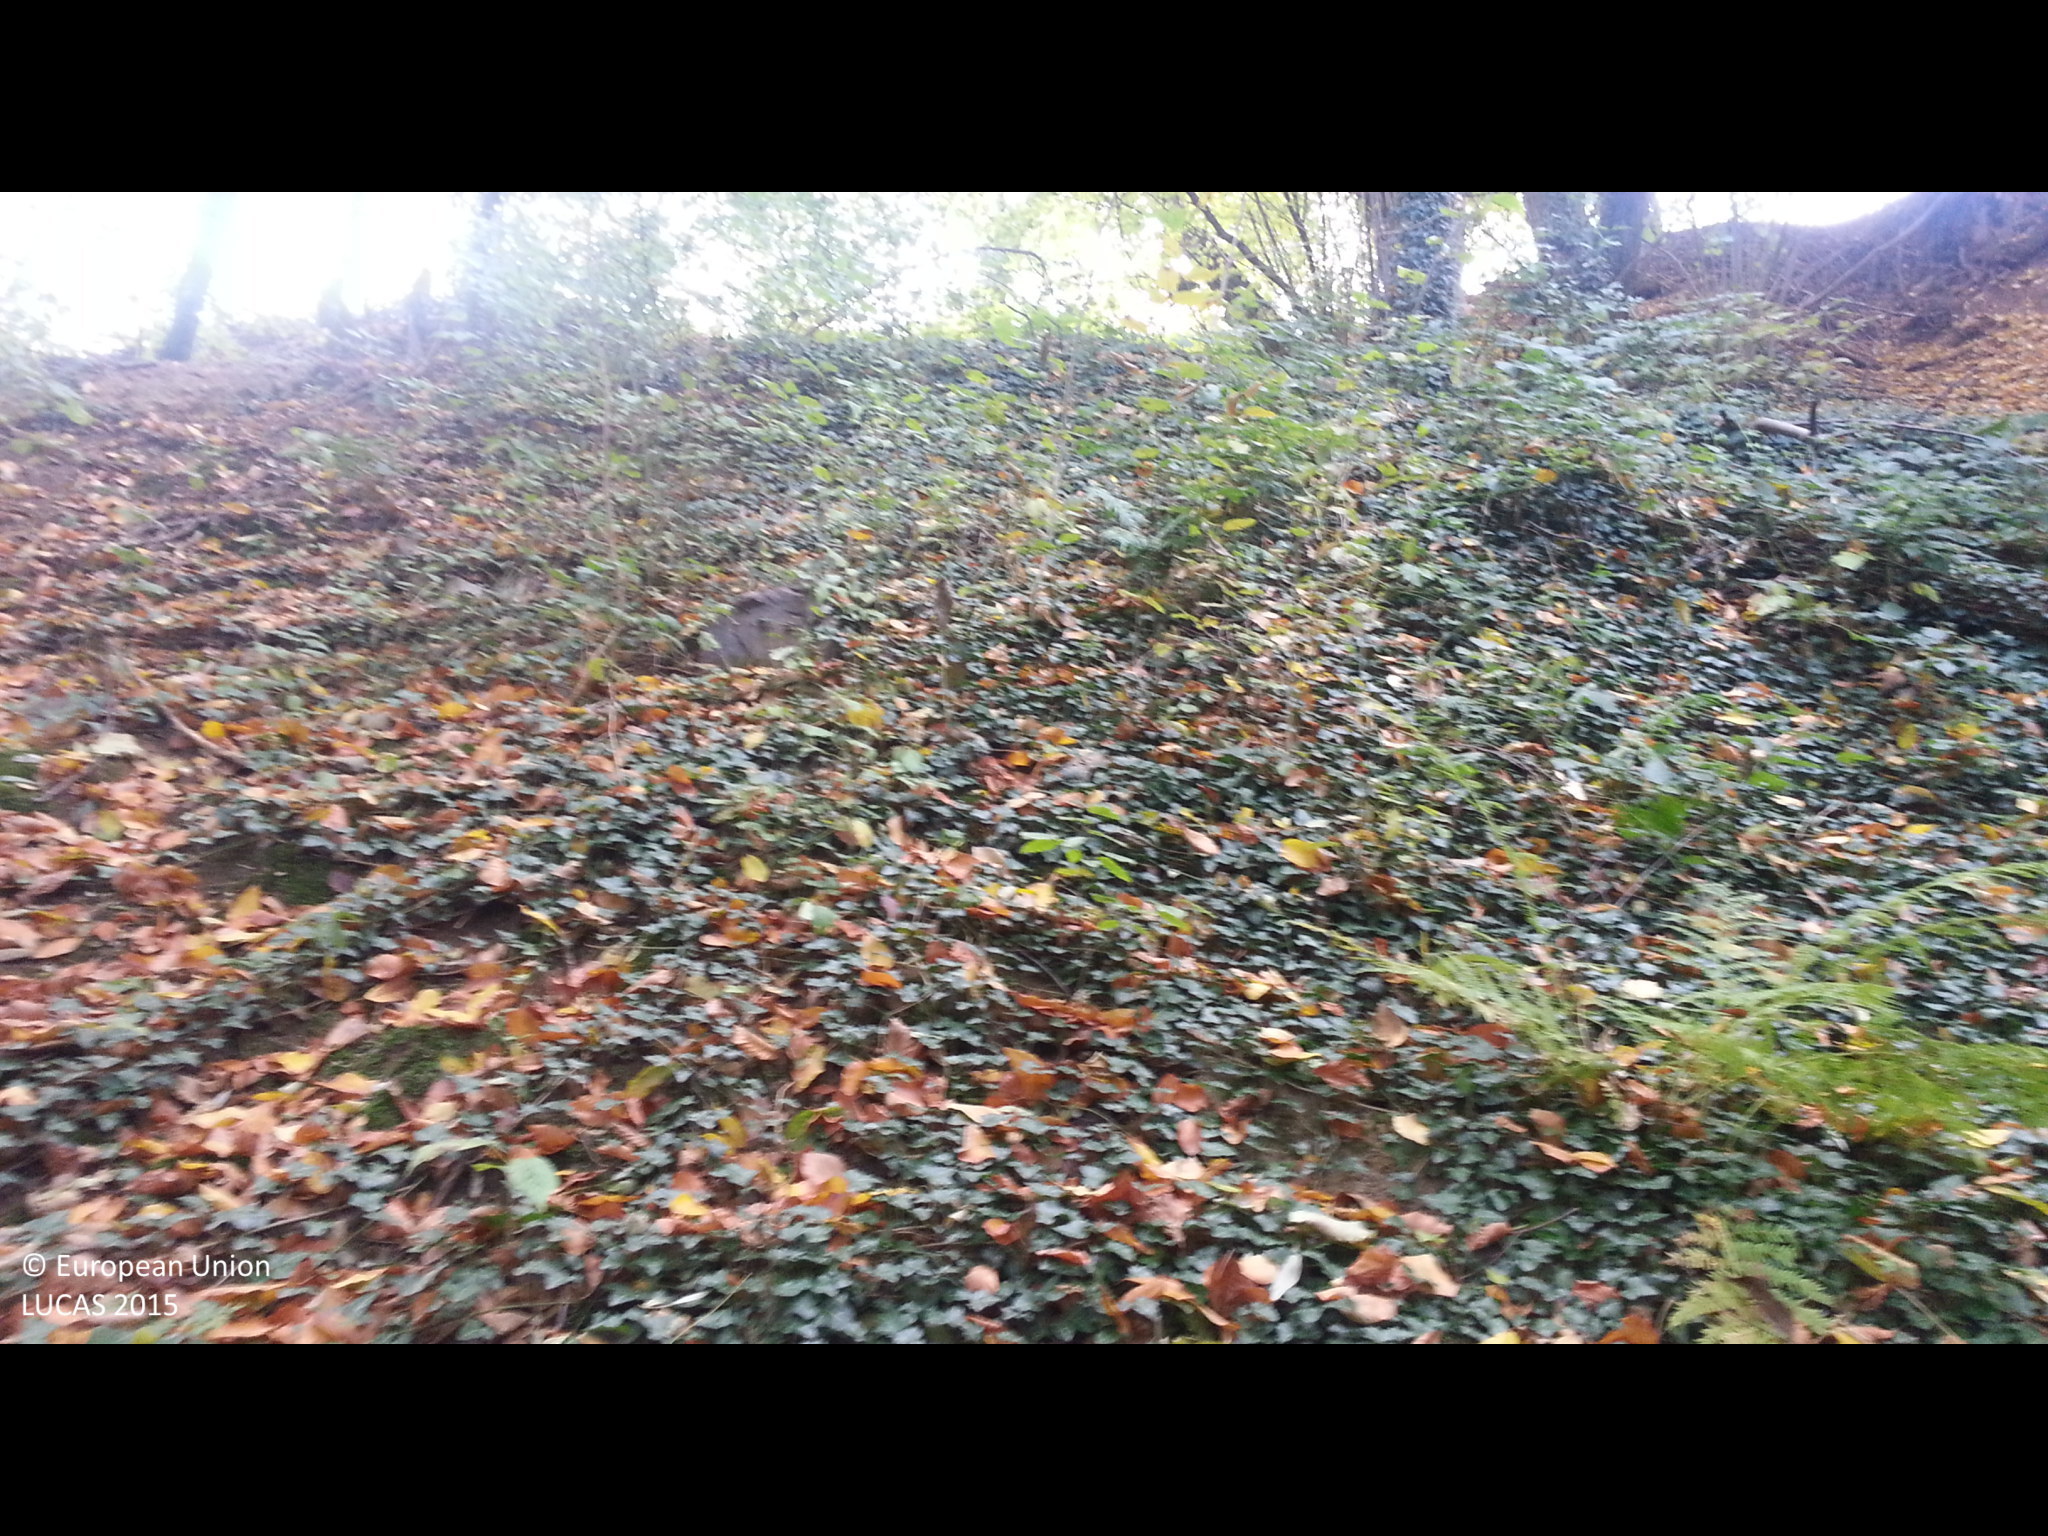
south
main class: Woodland
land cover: Broadleaved woodland
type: mesophytic deciduous forest
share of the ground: 50 - 75 %
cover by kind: broadleaved forest trees 55 %, consolidated bare surface 35 %, shrubs 5 %, herbaceous plants 5 %
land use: Forestry
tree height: > 5 m
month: November
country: BG
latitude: 42.8917
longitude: 23.9442
